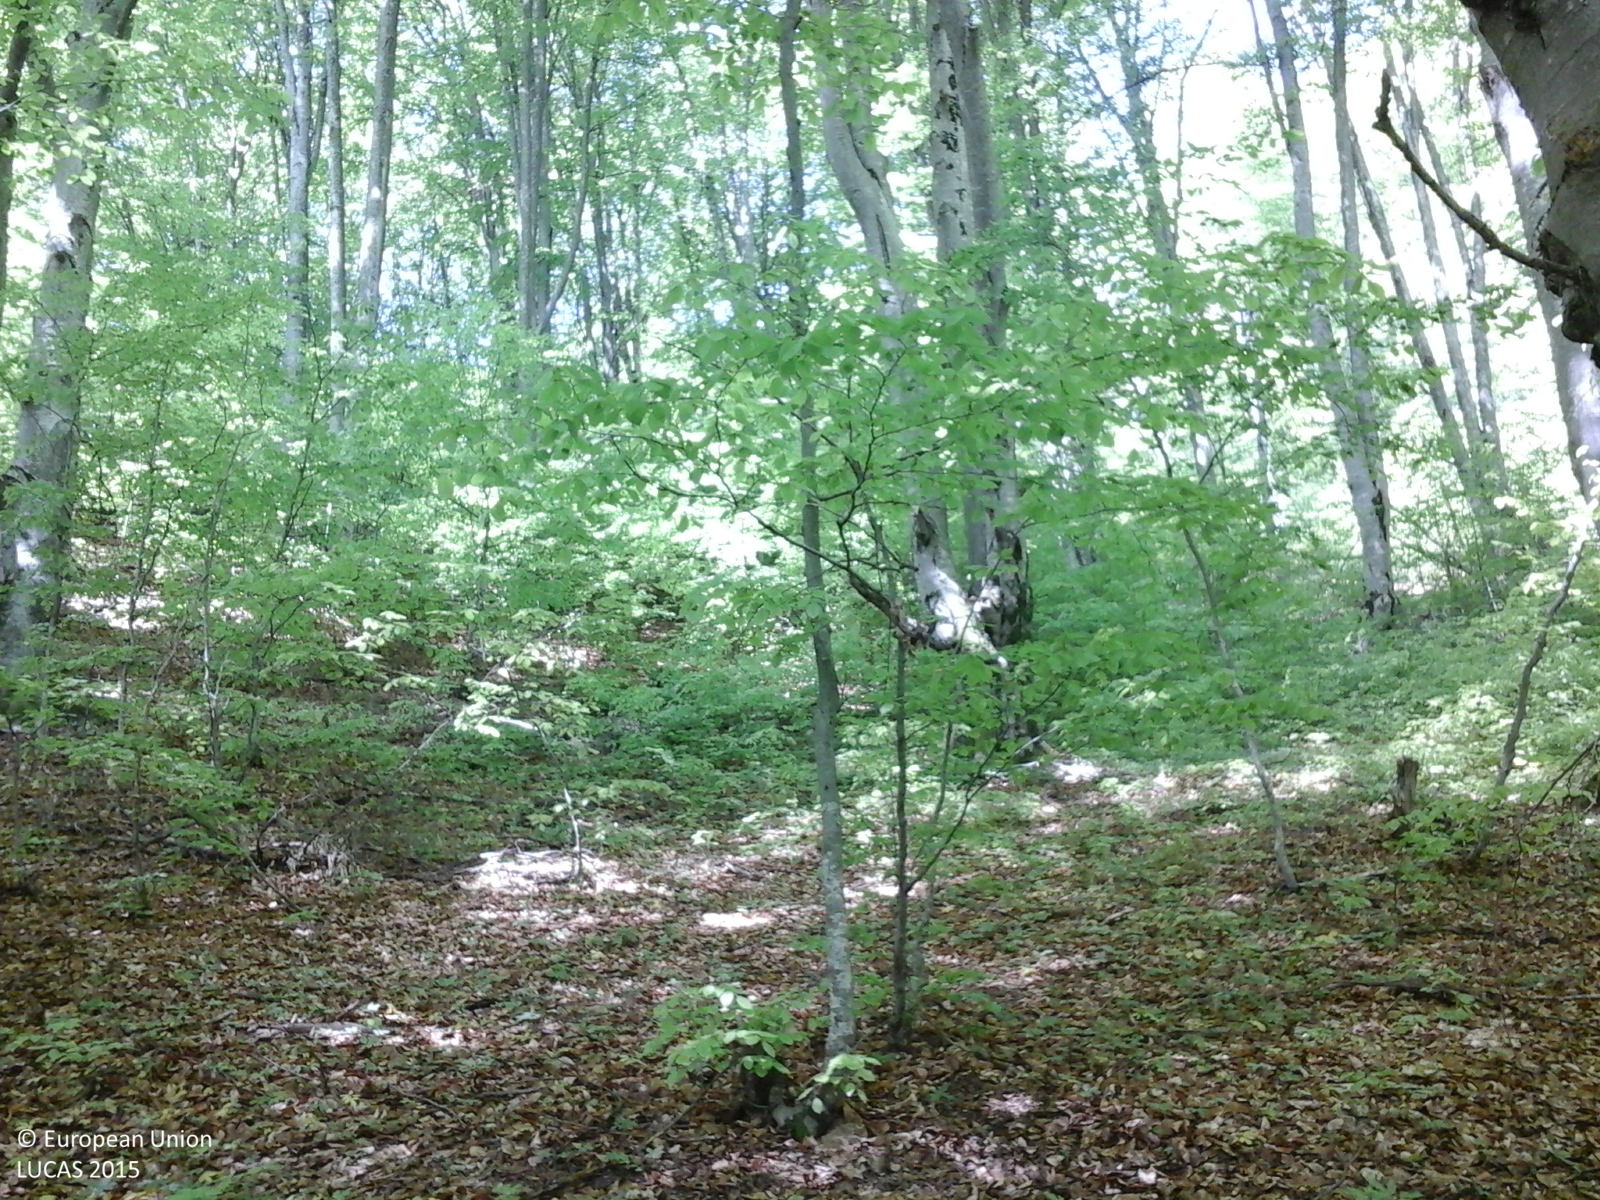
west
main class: Woodland
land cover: Broadleaved woodland
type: beech forest
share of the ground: > 75 %
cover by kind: broadleaved forest trees 100 %
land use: Forestry
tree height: > 5 m
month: May
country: RO
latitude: 45.7052
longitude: 26.0032
